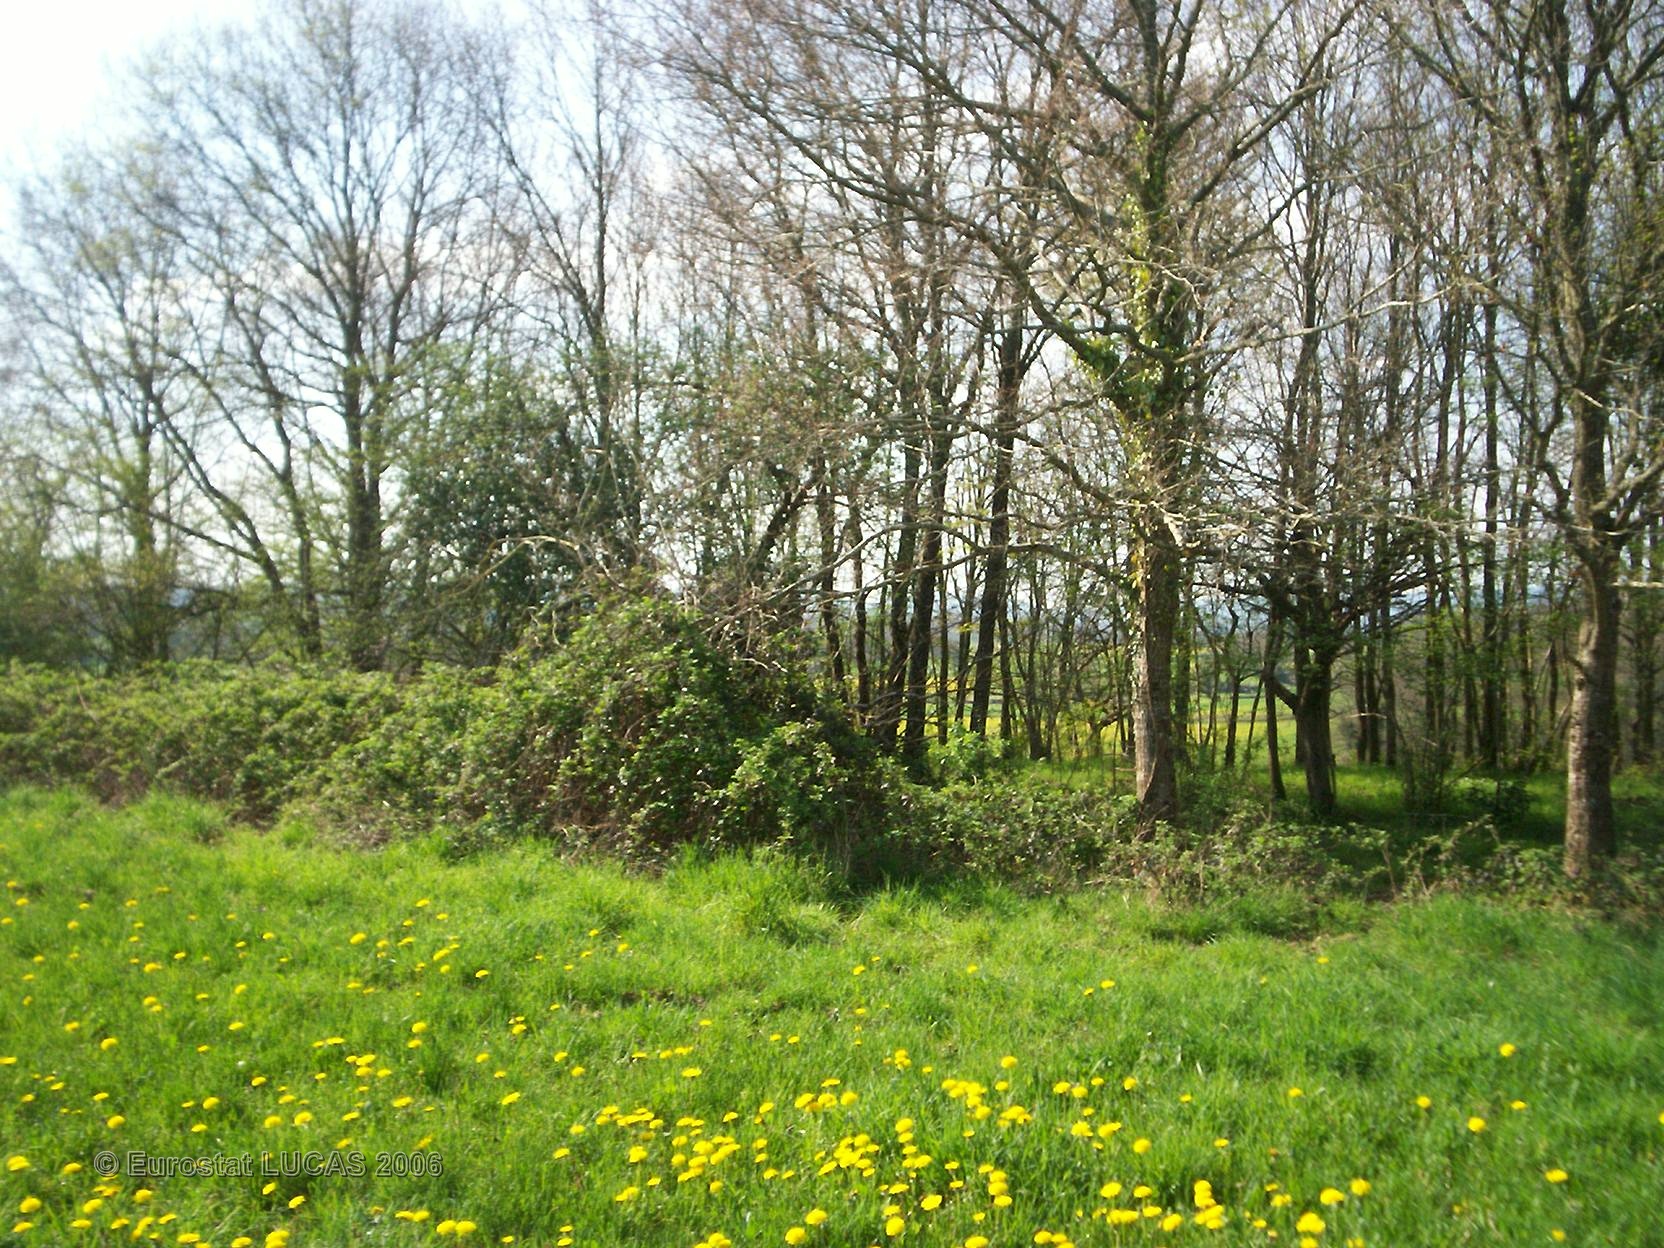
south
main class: Grassland
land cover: Grassland with sparse tree/shrub cover
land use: Agriculture (excluding fallow land and kitchen gardens)
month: April
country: FR
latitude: 46.1559
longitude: 1.4835
